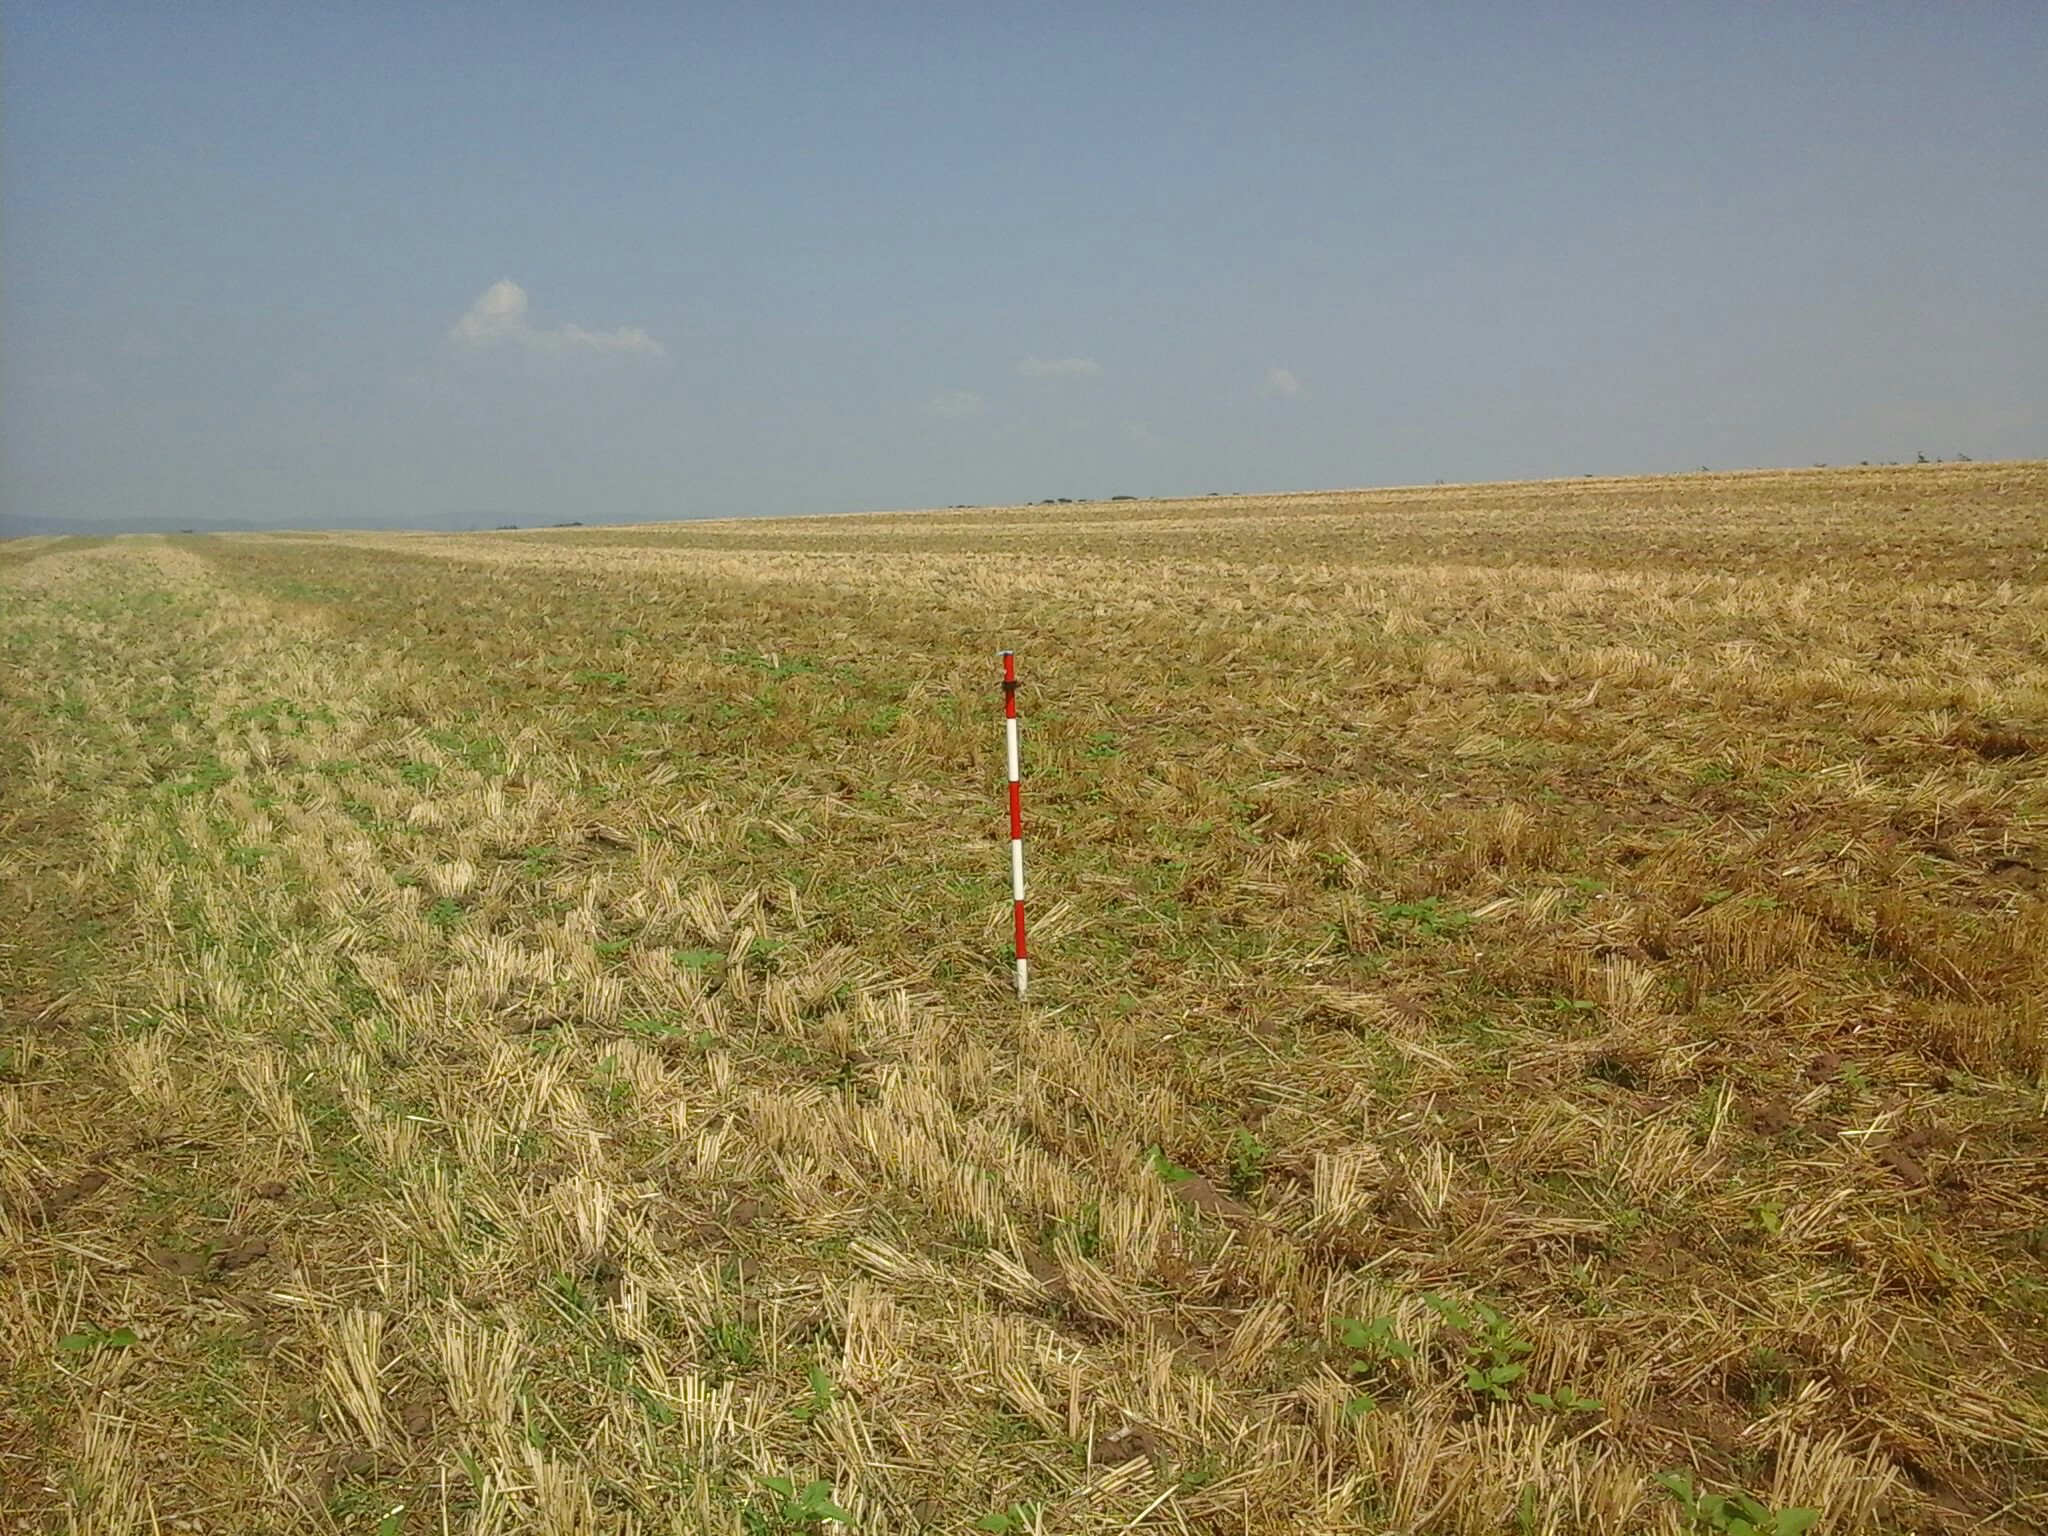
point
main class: Cropland
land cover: Common wheat
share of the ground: < 10 %
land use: Agriculture (excluding fallow land and kitchen gardens)
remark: Harvested field
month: August
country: HU
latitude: 47.3479
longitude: 18.5516
